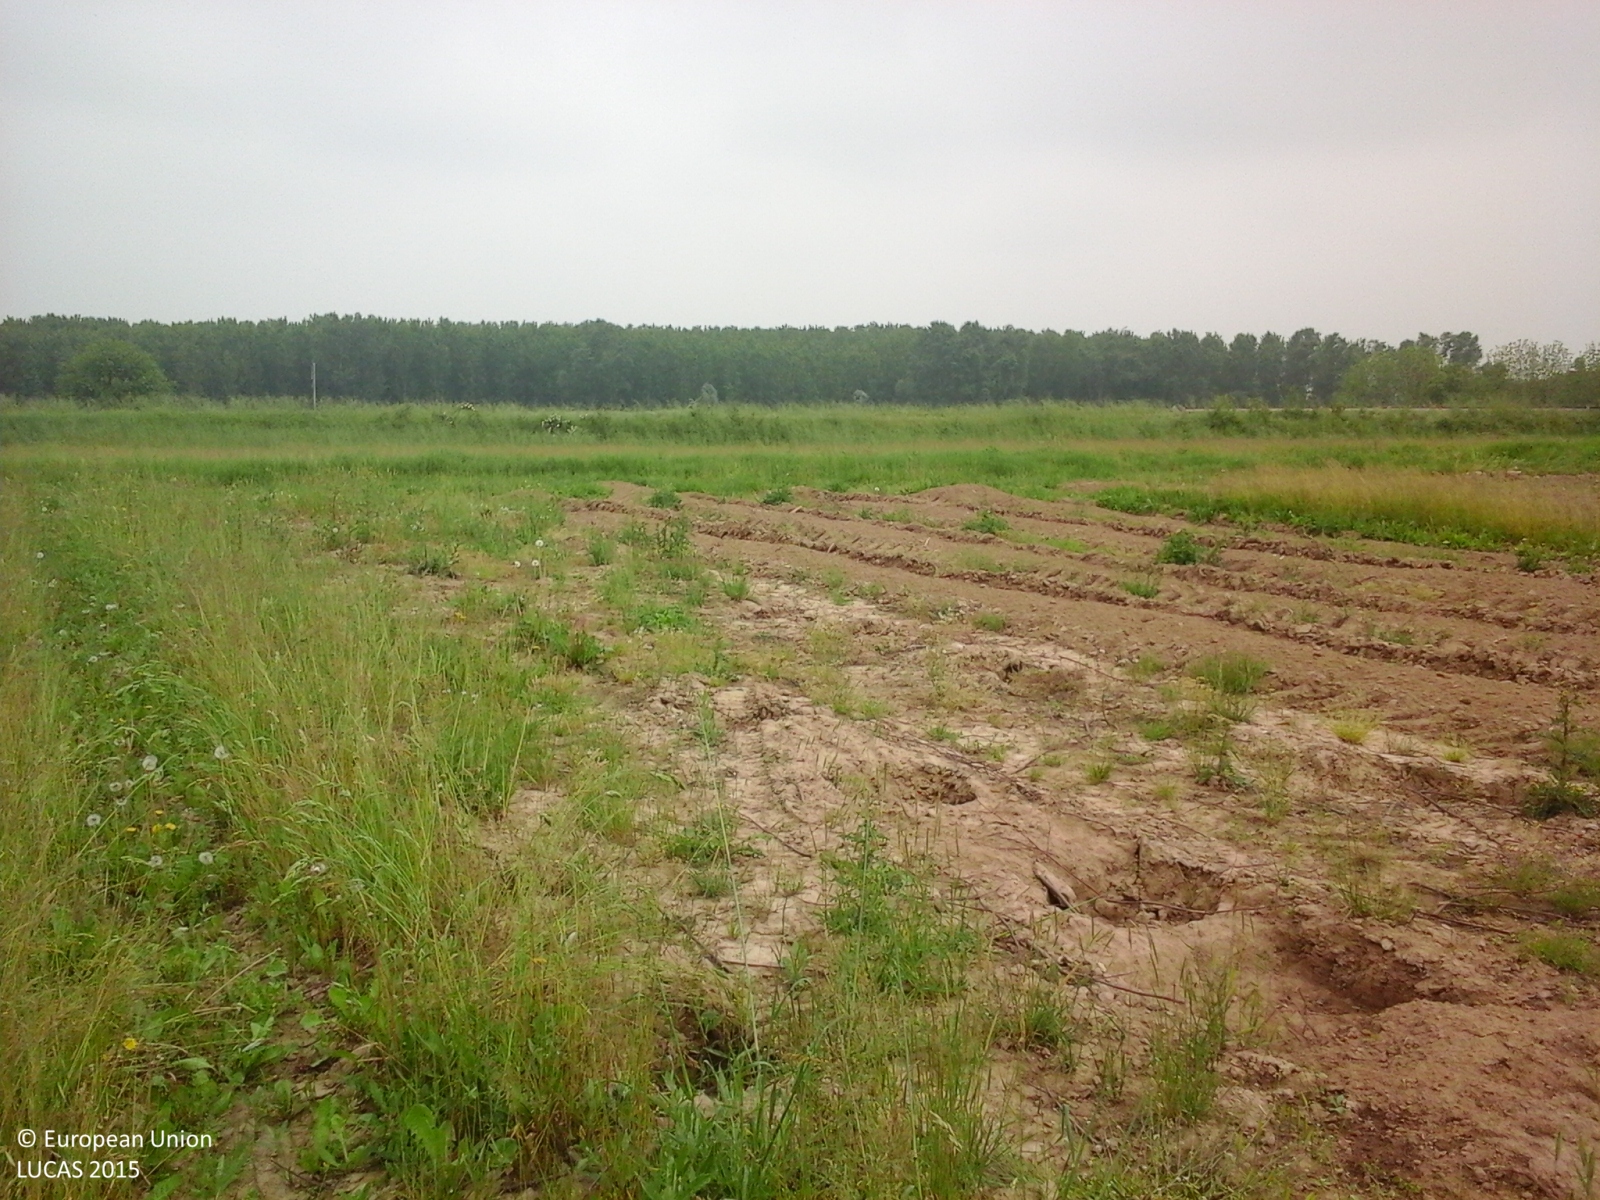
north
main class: Grassland
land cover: Spontaneously vegetated surfaces
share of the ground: > 75 %
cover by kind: herbaceous plants 100 %
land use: Fallow land
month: May
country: IT
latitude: 45.1252
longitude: 10.3934
